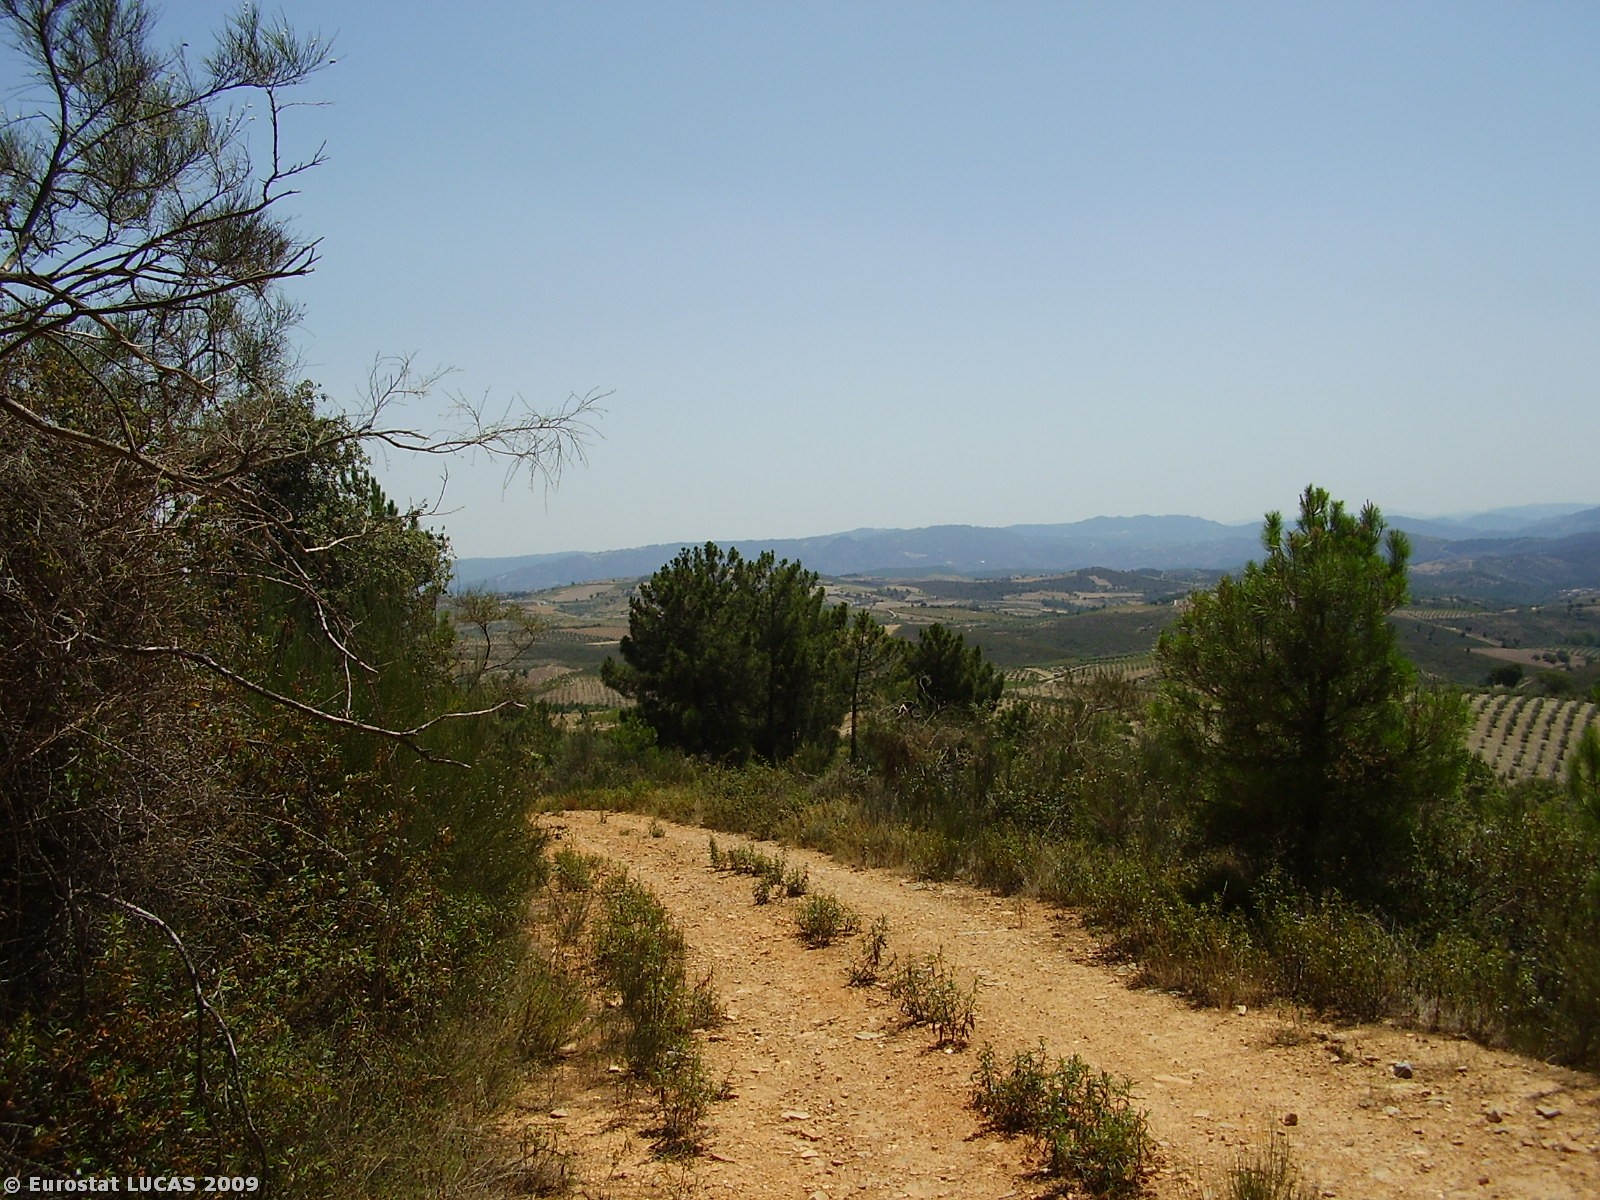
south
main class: Shrubland
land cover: Shrubland with sparse tree cover
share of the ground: 50 - 75 %
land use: Unused
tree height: > 5 m
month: July
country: PT
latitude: 41.4431
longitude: -7.3212
